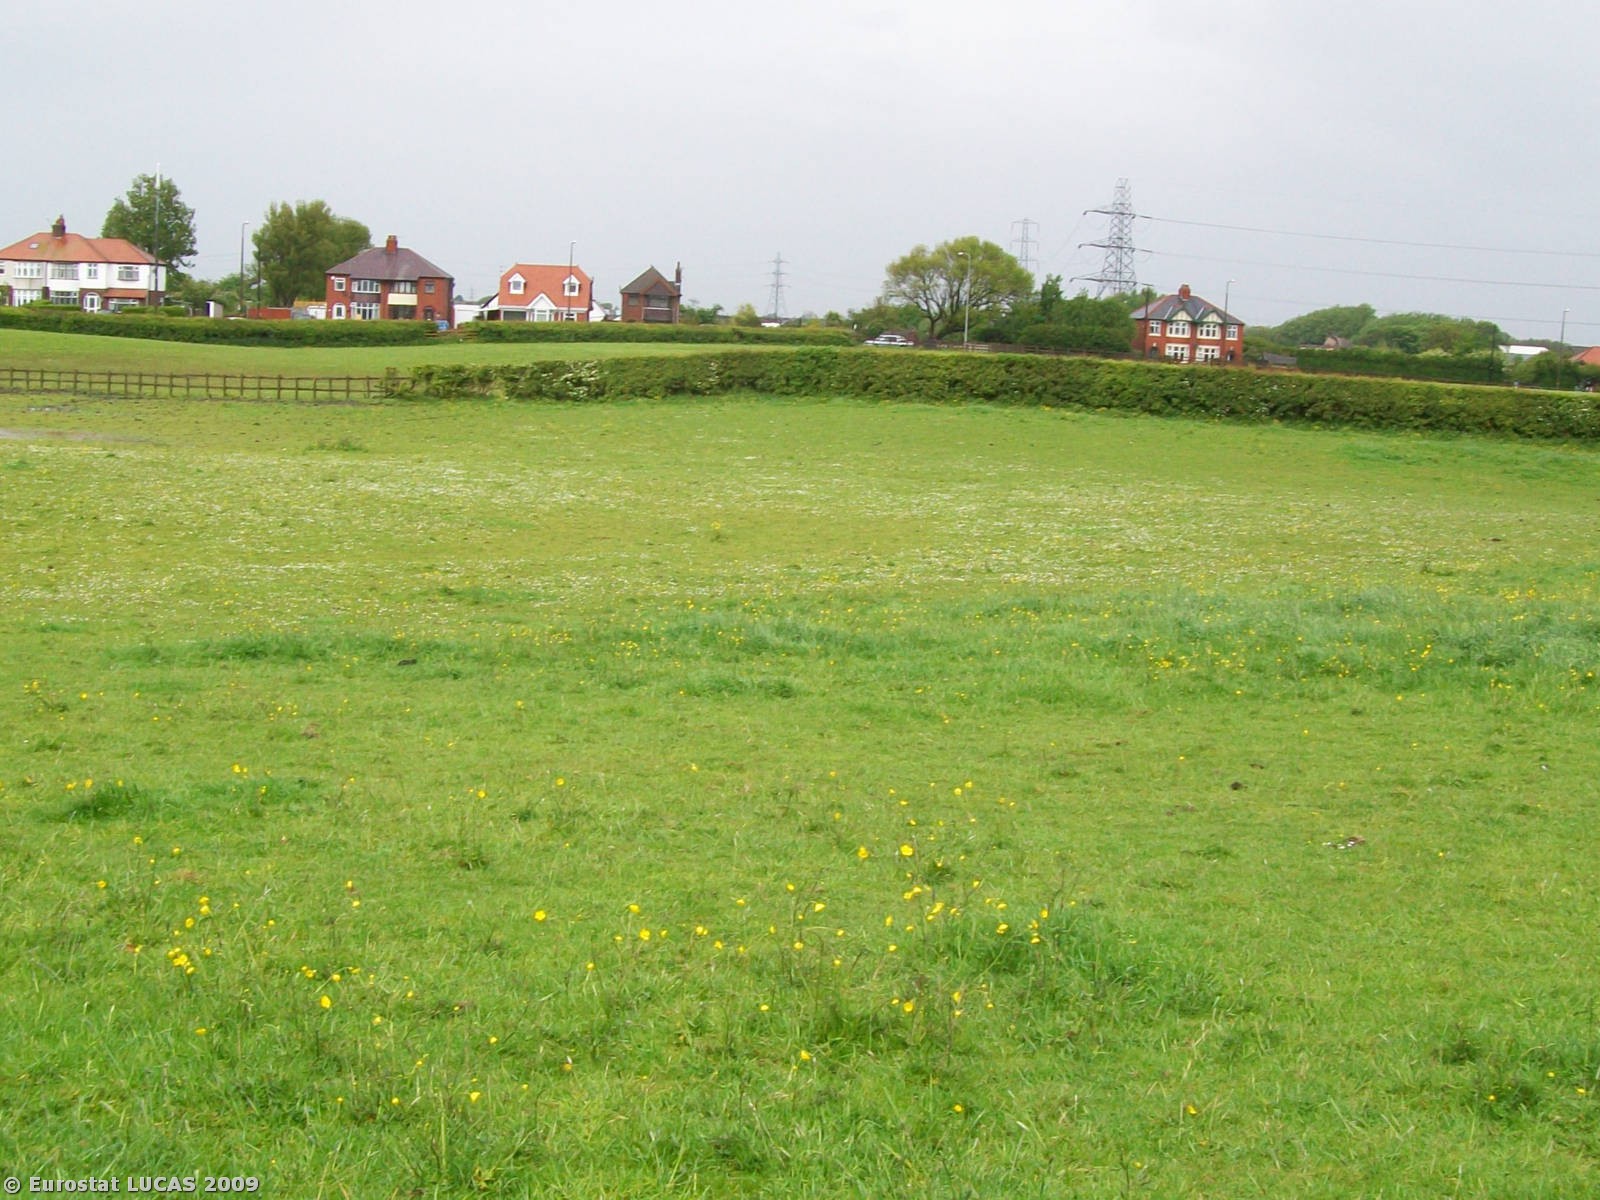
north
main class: Grassland
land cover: Grassland without tree/shrub cover
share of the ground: > 75 %
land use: Agriculture (excluding fallow land and kitchen gardens)
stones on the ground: < 10 %
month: May
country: GB
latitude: 53.8269
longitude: -3.0027
